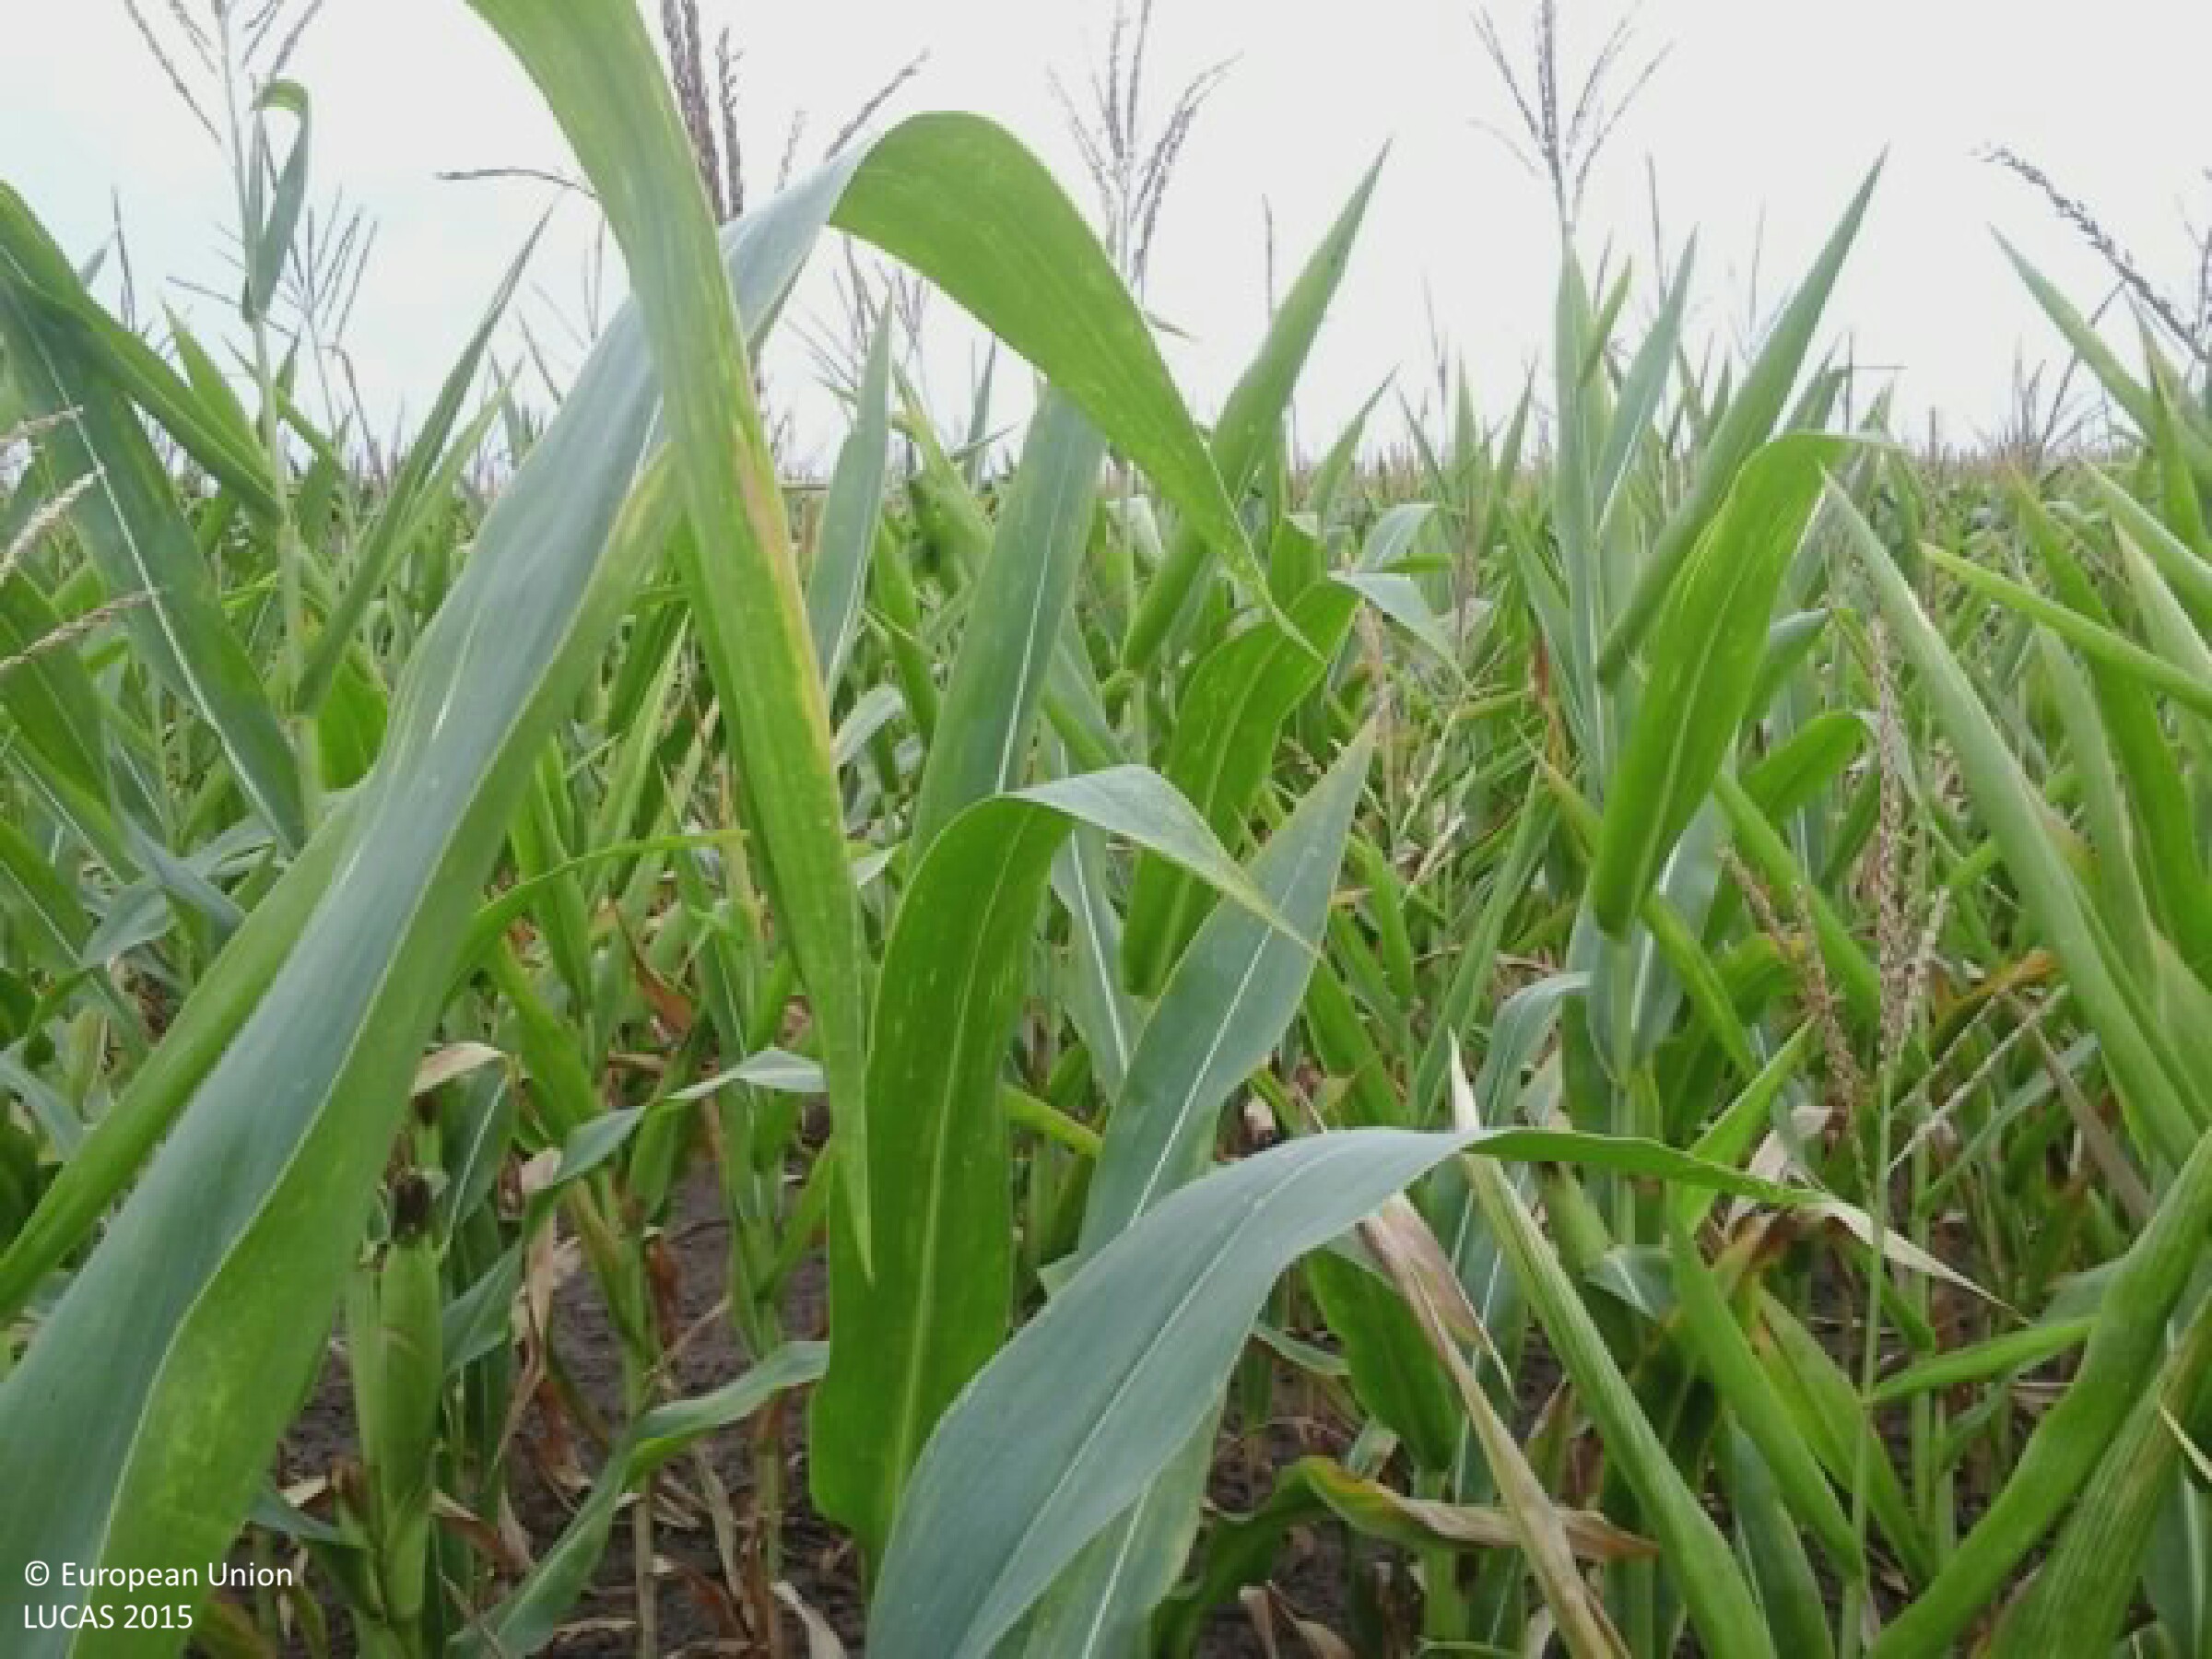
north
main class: Cropland
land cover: Maize
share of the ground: > 75 %
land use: Agriculture (excluding fallow land and kitchen gardens)
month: July
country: HU
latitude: 46.9760
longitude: 19.7358
